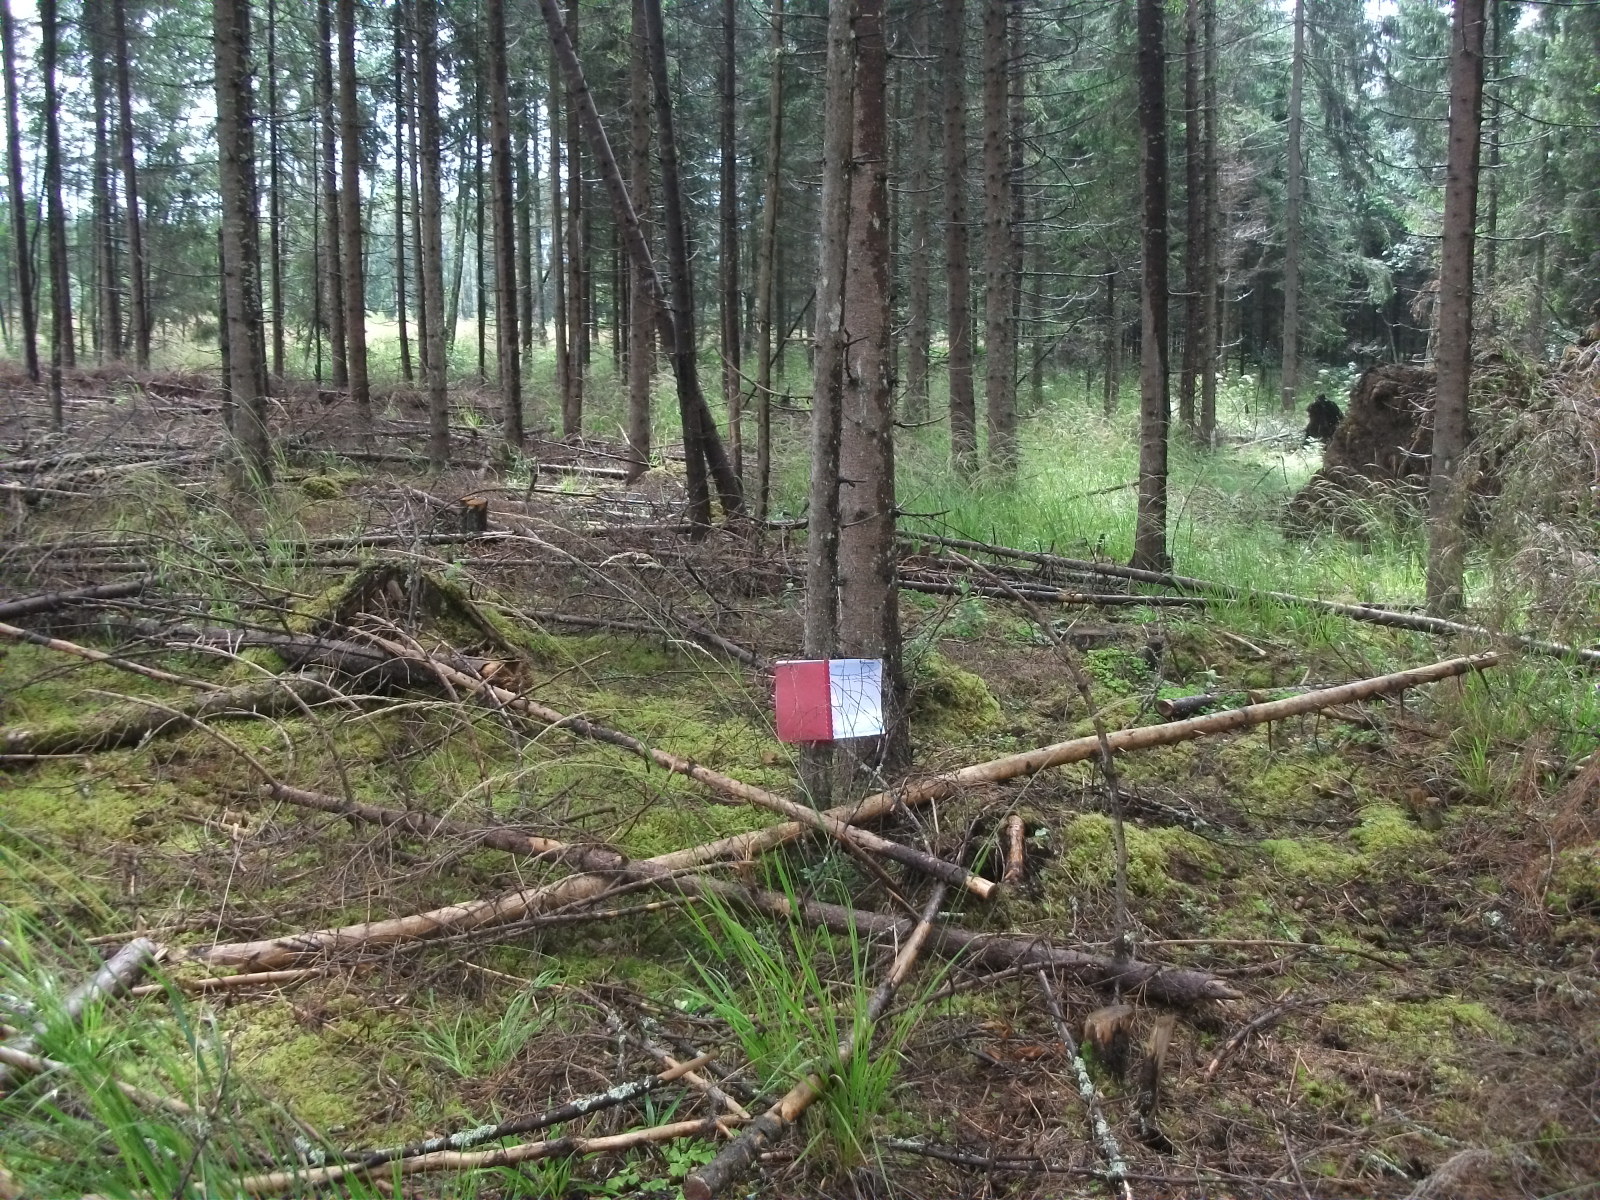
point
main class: Woodland
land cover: Spruce dominated coniferous woodland
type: hemiboreal forest and nemoral coniferous forest and mixed broadleaved-coniferous forest
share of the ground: 50 - 75 %
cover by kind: coniferous forest trees 60 %, herbaceous plants 15 %, lichens and mosses 15 %, unconsolidated bare surface 5 %
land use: Forestry
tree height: > 5 m
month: July
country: LV
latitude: 56.9729
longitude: 25.8711
